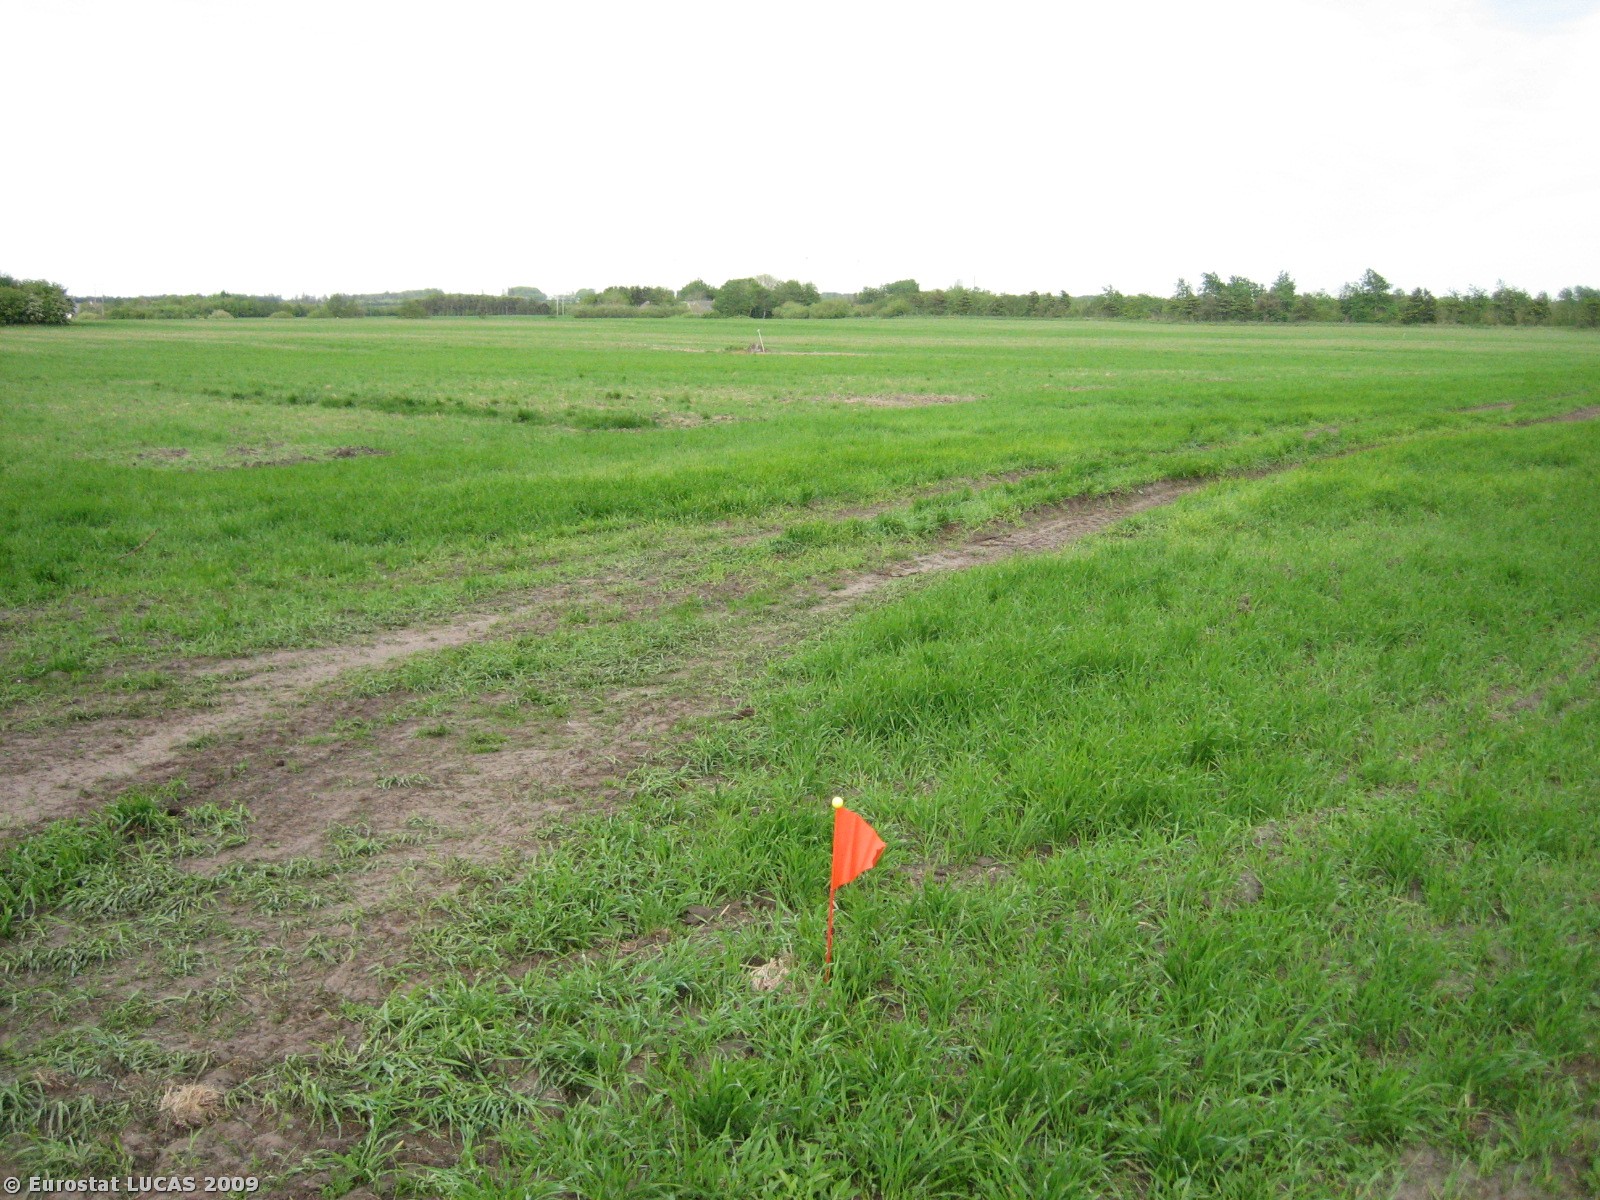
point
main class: Cropland
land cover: Barley
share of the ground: > 75 %
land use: Agriculture (excluding fallow land and kitchen gardens)
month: May
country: DK
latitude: 56.0872
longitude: 8.3465
